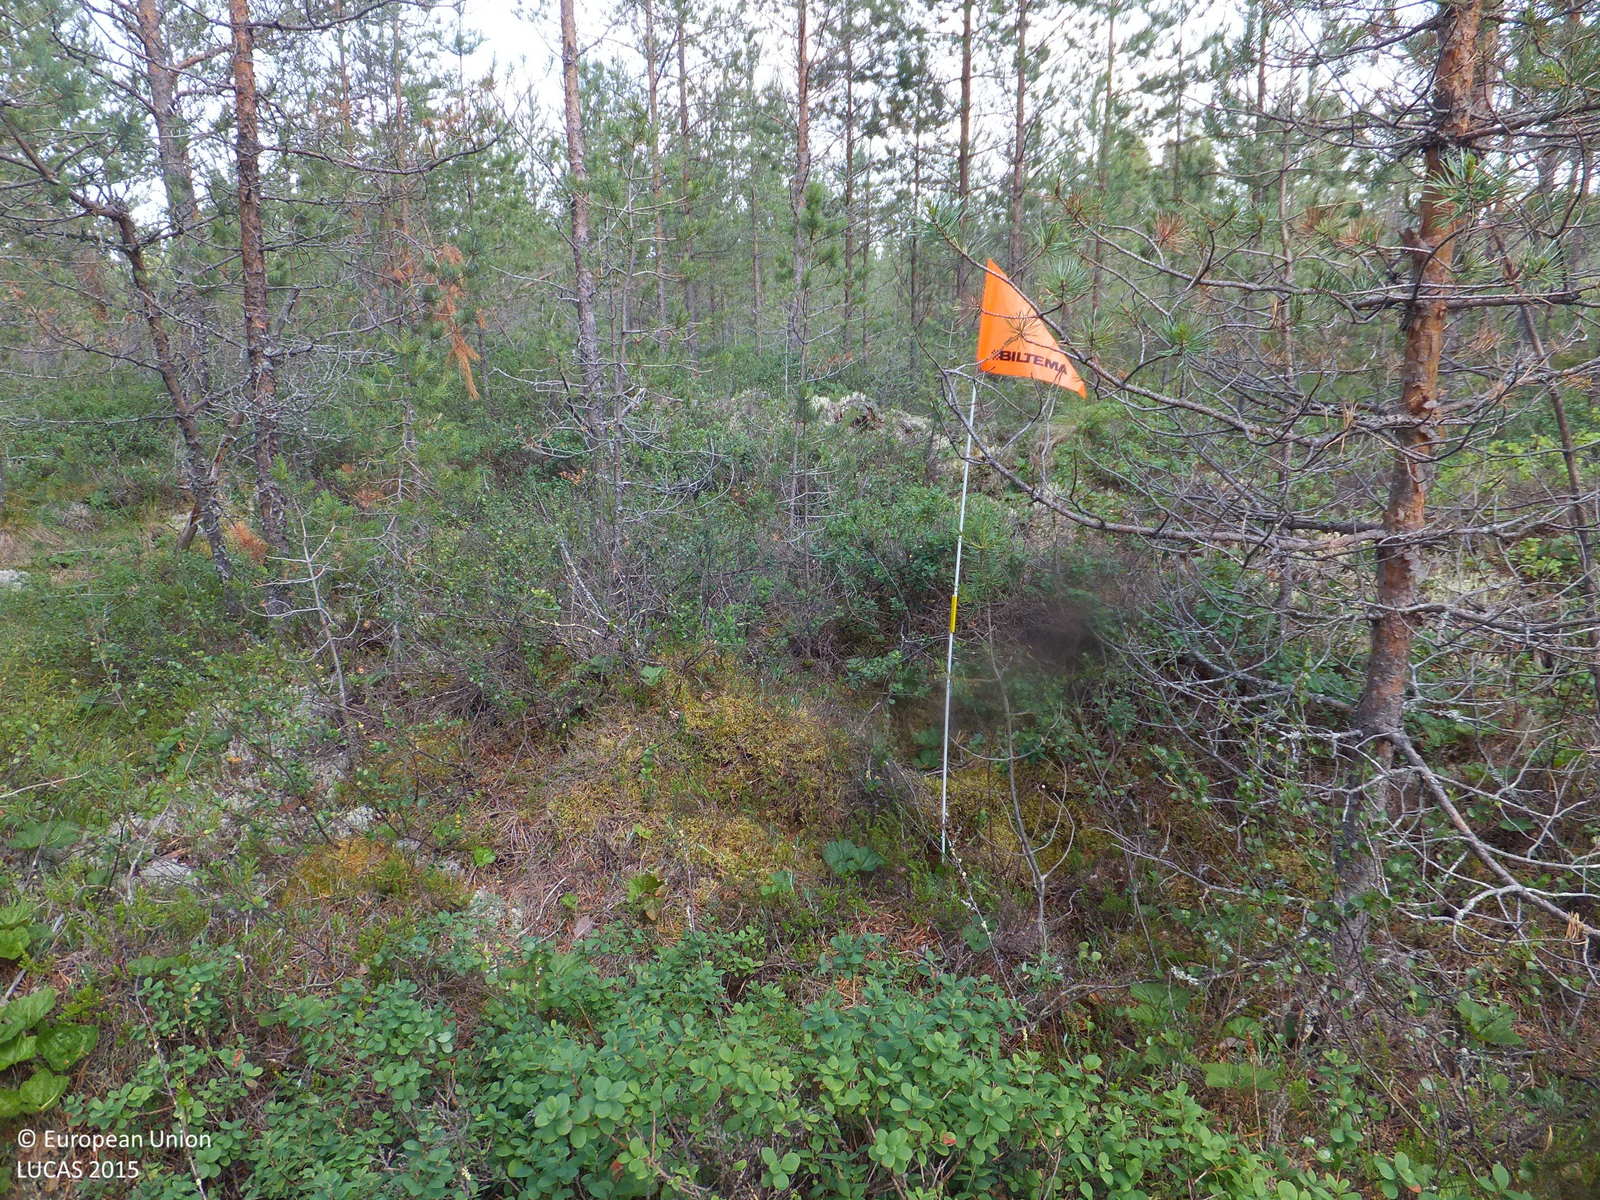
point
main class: Woodland
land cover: Pine dominated coniferous woodland
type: boreal forest
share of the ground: 25 - 50 %
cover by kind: coniferous forest trees 30 %, shrubs 30 %, lichens and mosses 30 %, herbaceous plants 10 %
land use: Forestry
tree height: < 5 m
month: July
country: FI
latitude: 63.5823
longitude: 23.2527
